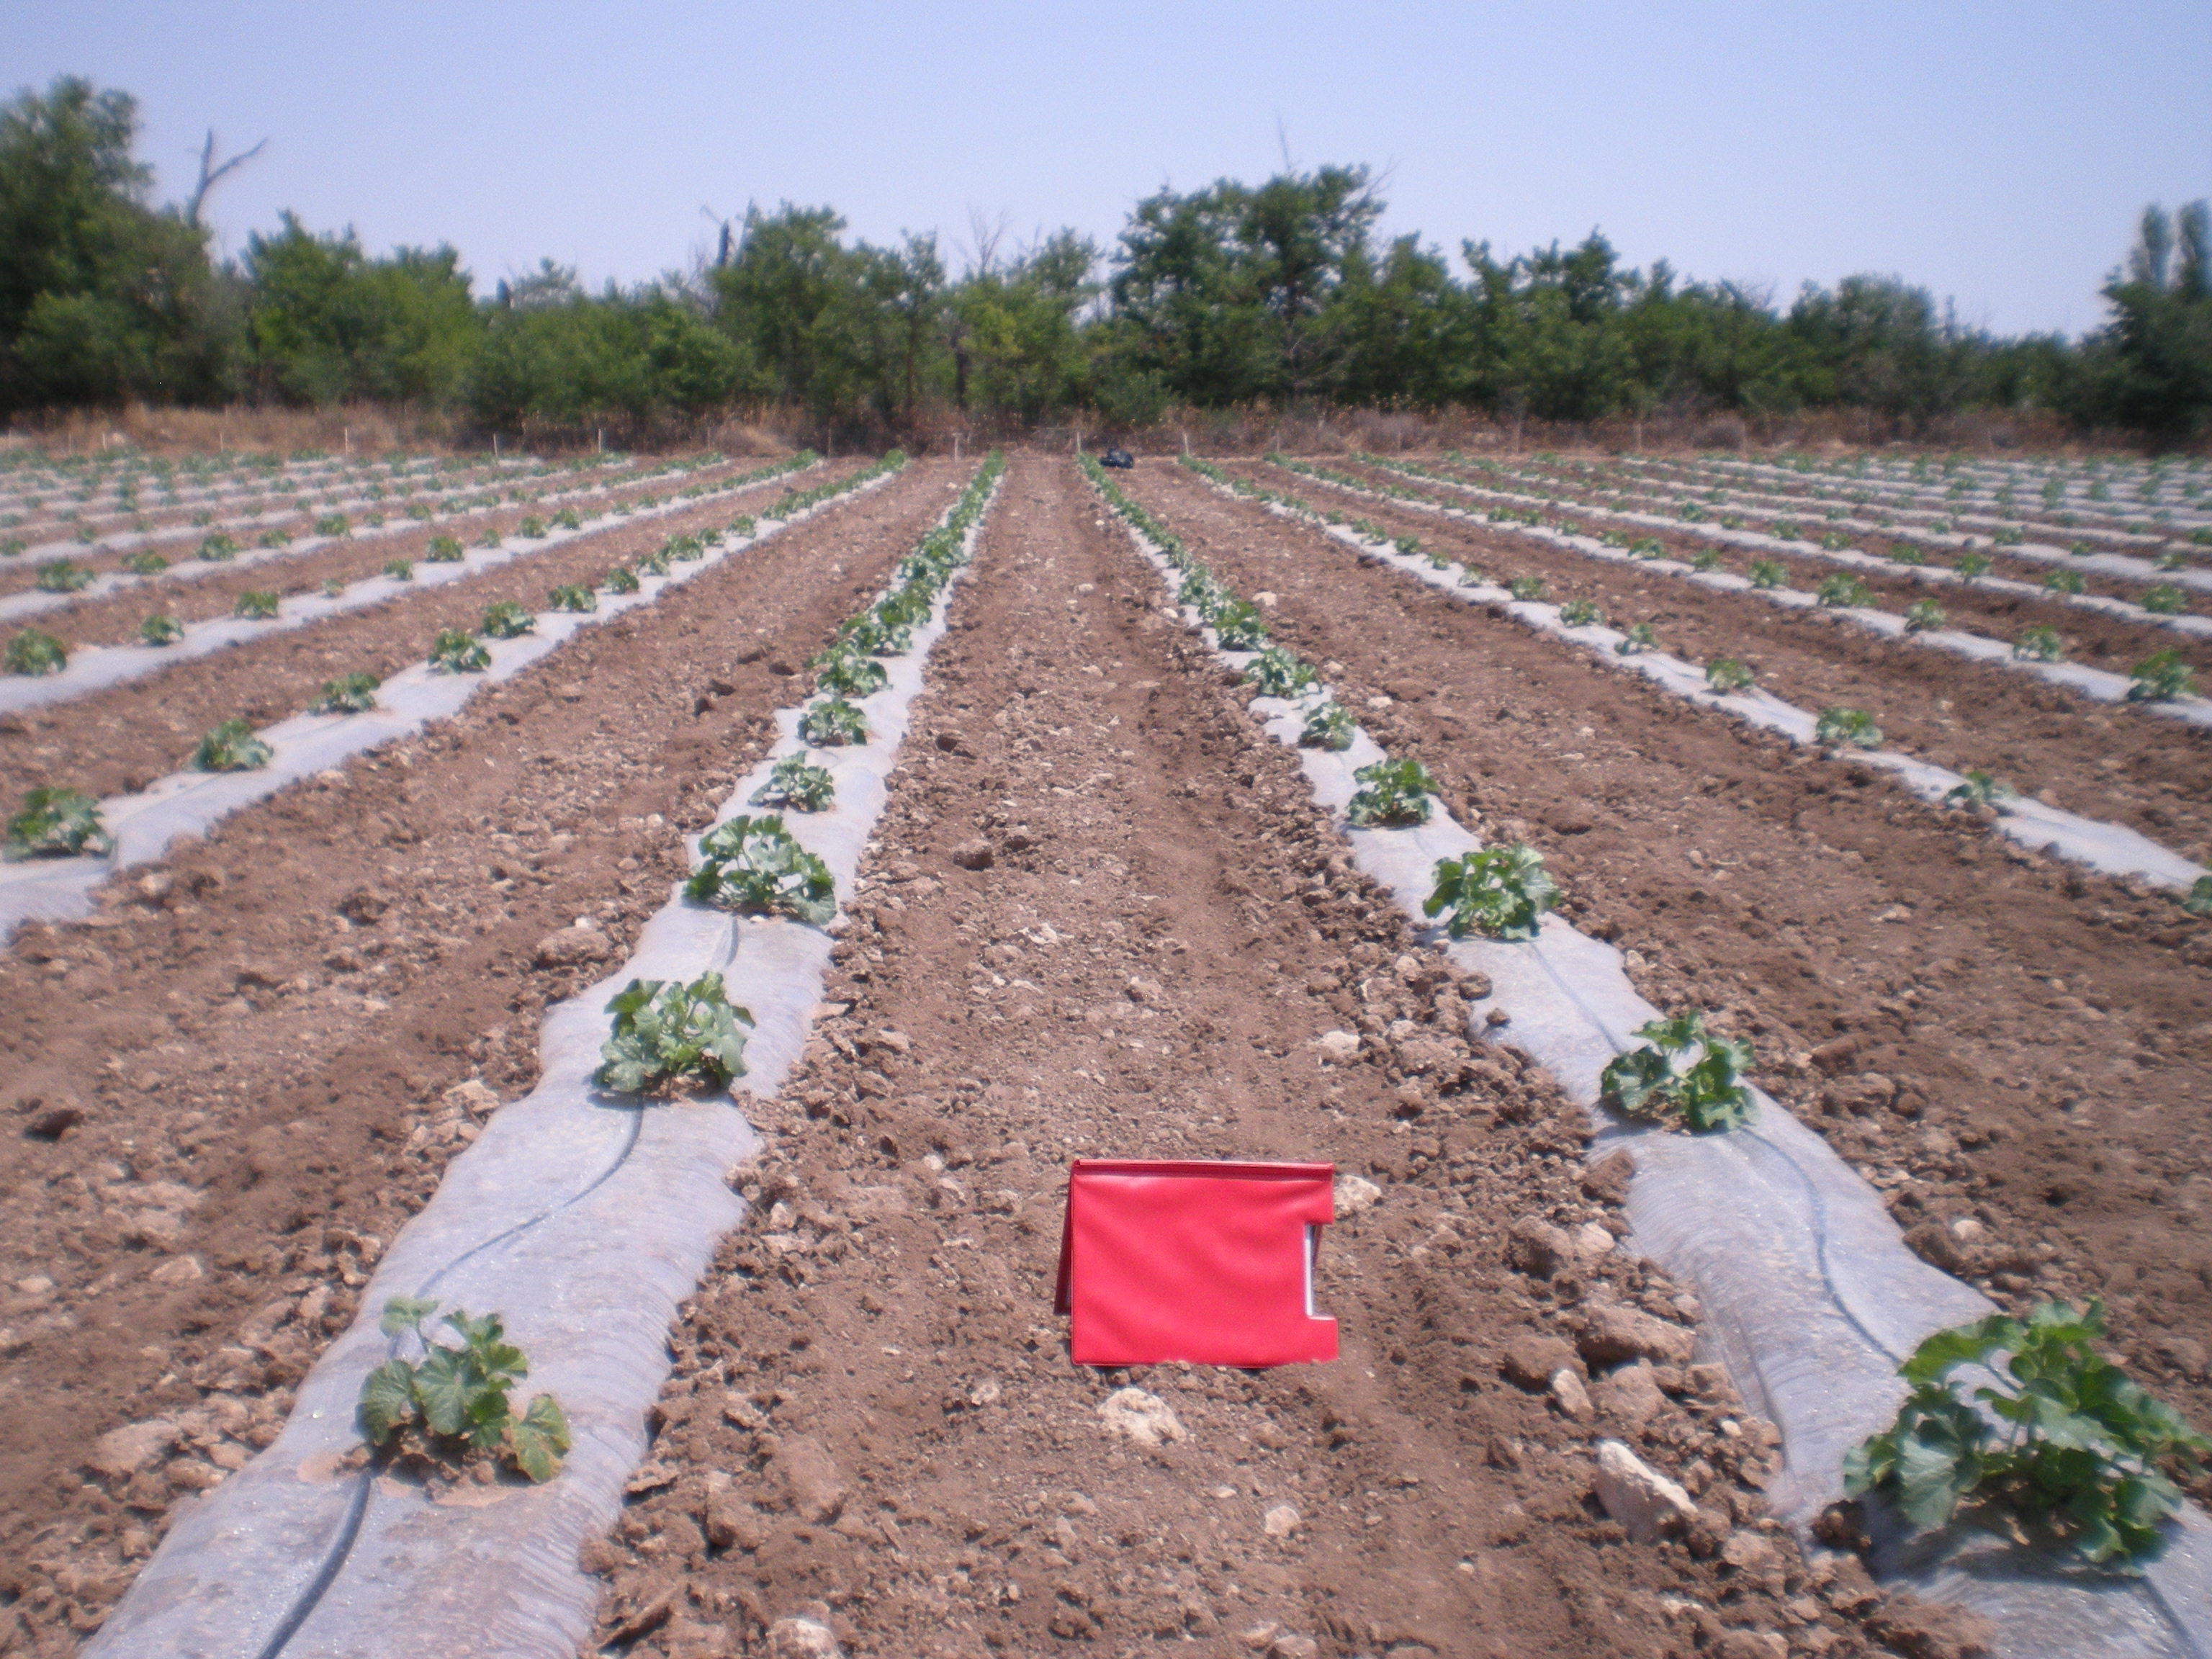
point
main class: Cropland
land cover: Other fresh vegetables
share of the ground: < 10 %
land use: Agriculture (excluding fallow land and kitchen gardens)
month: June
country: ES
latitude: 39.6666
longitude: -3.1818
